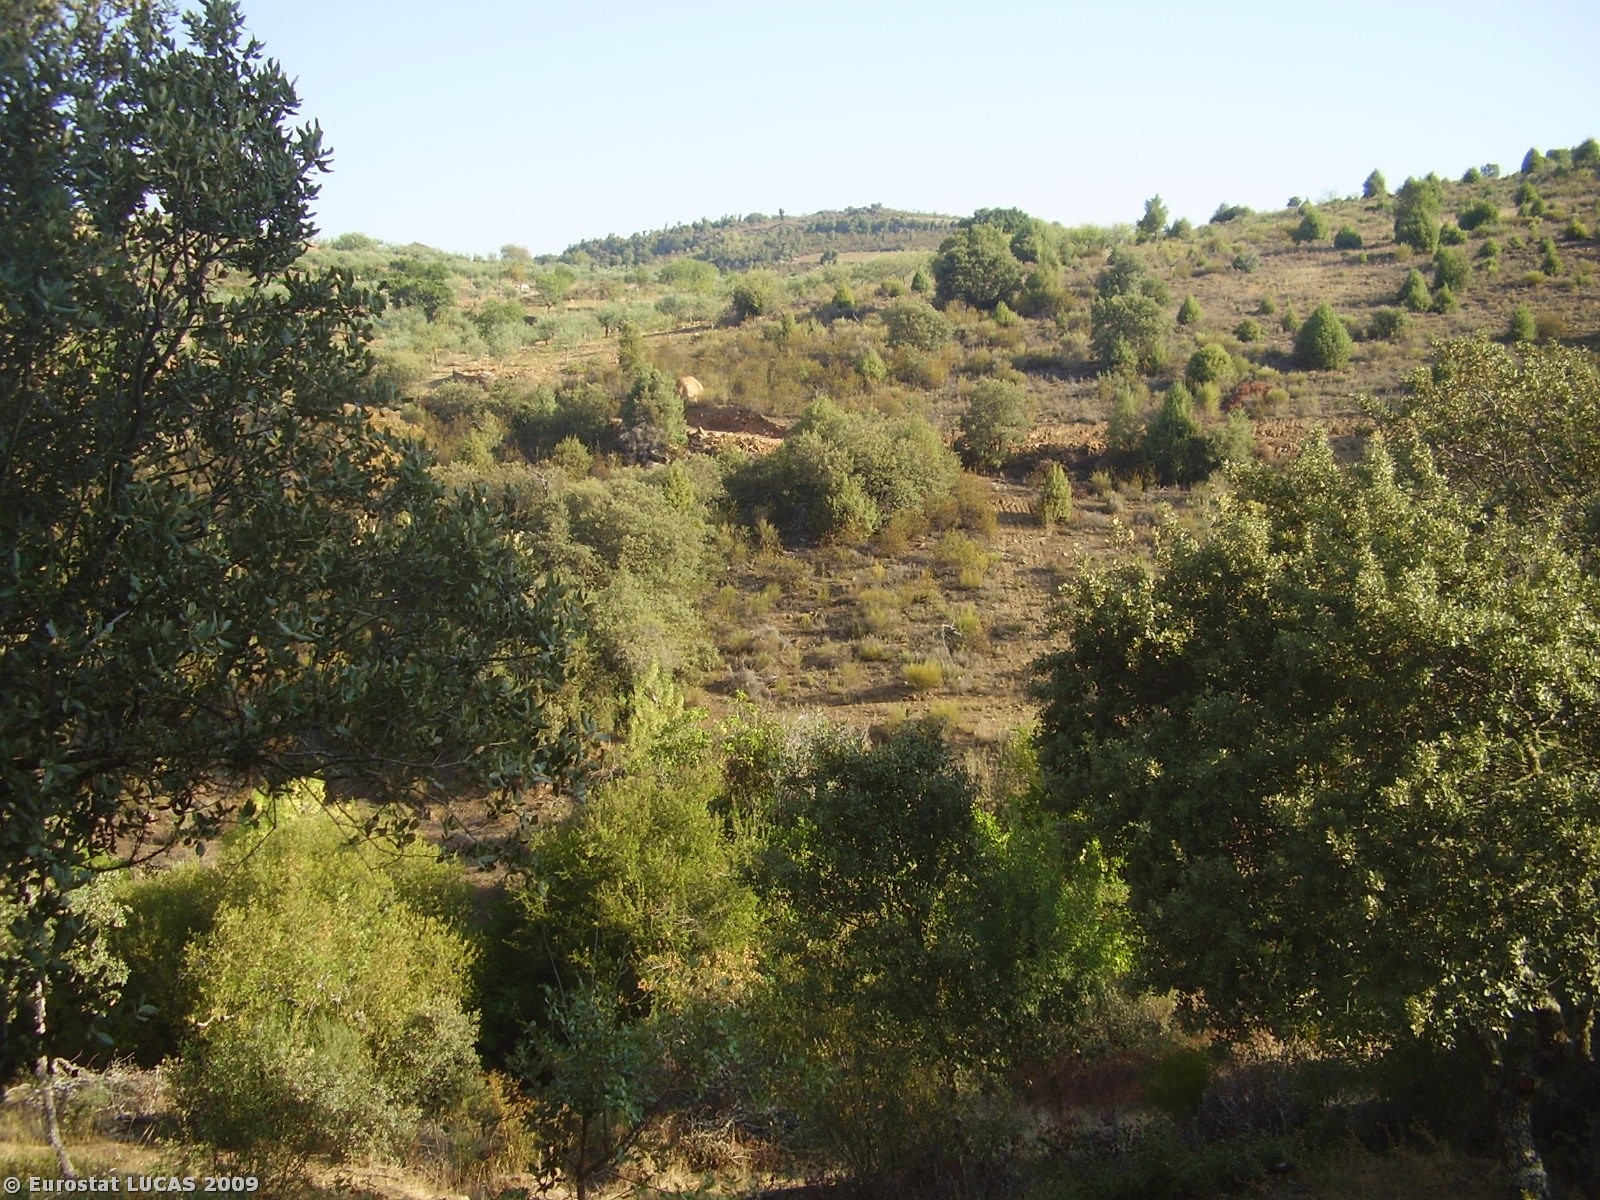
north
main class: Woodland
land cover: Broadleaved woodland
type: broadleaved evergreen forest
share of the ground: 10 - 25 %
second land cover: Spontaneously vegetated surfaces
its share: > 75 %
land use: Forestry
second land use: Fallow land
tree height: > 5 m
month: August
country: PT
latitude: 41.3879
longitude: -6.7904
